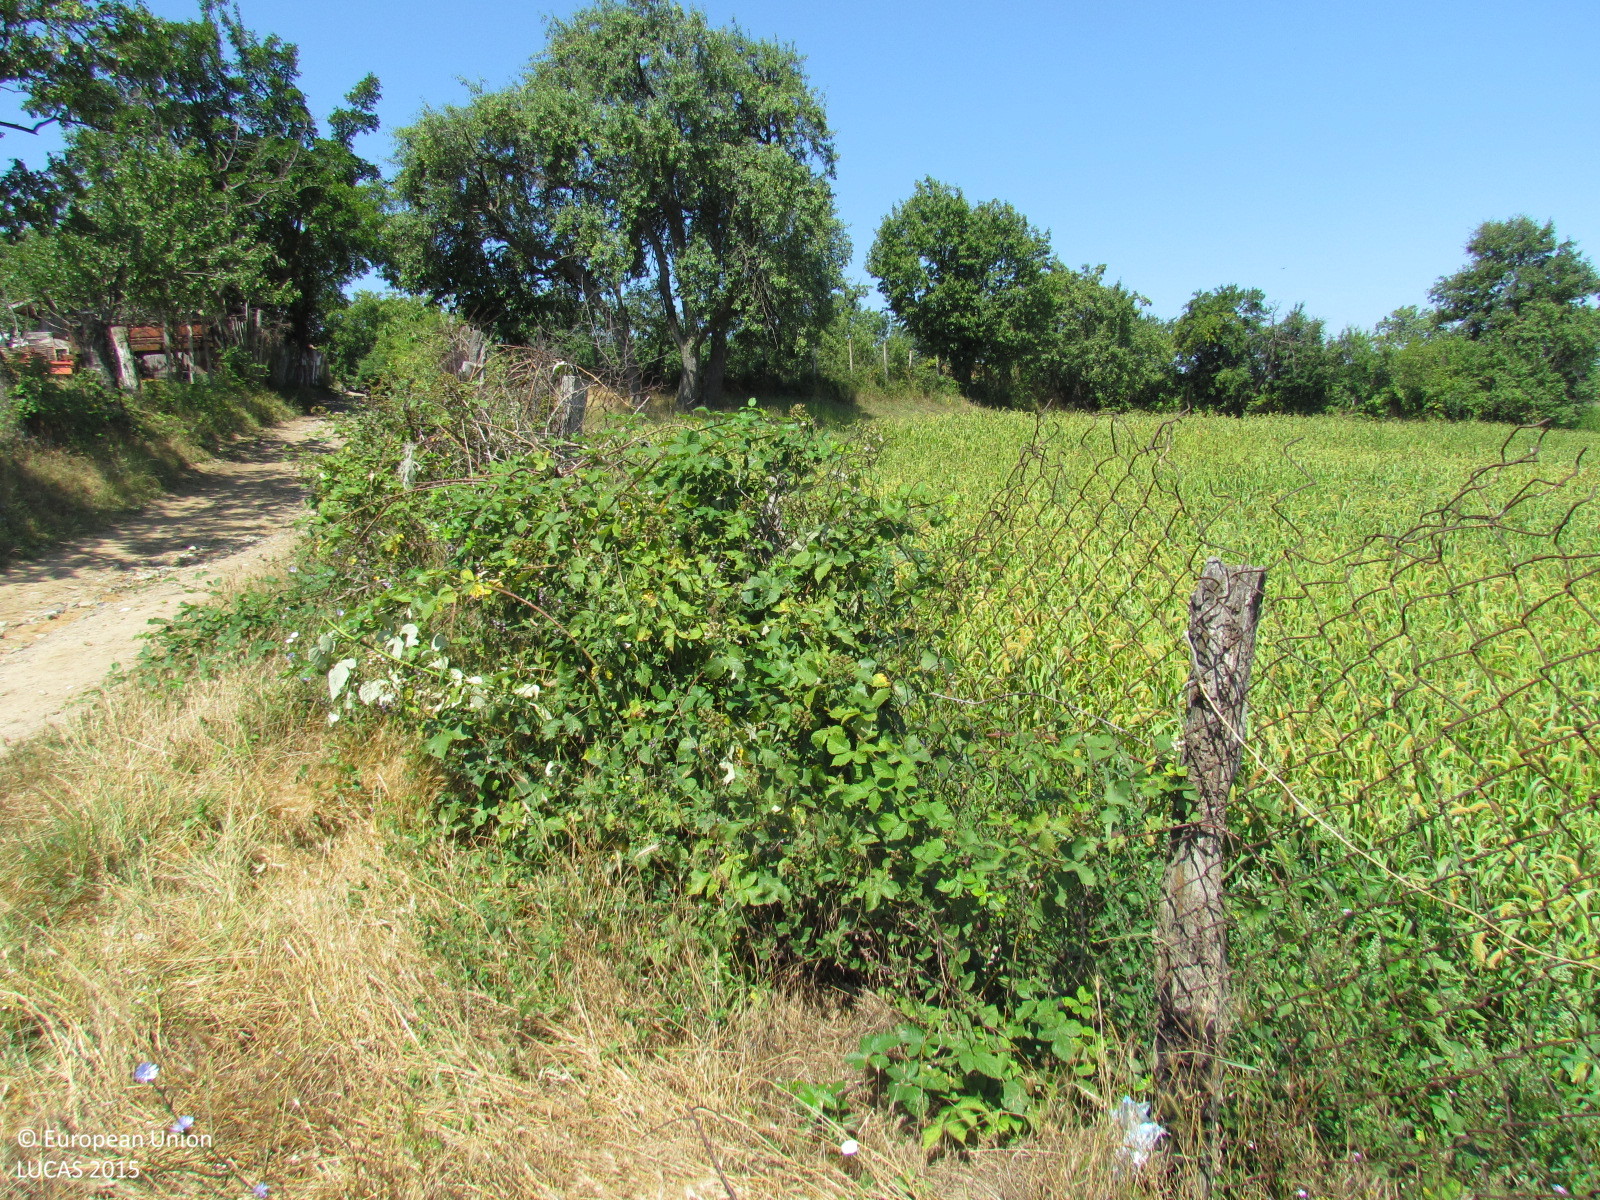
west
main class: Cropland
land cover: Common wheat
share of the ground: > 75 %
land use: Agriculture (excluding fallow land and kitchen gardens)
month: July
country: BG
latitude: 42.8640
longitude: 27.4152
